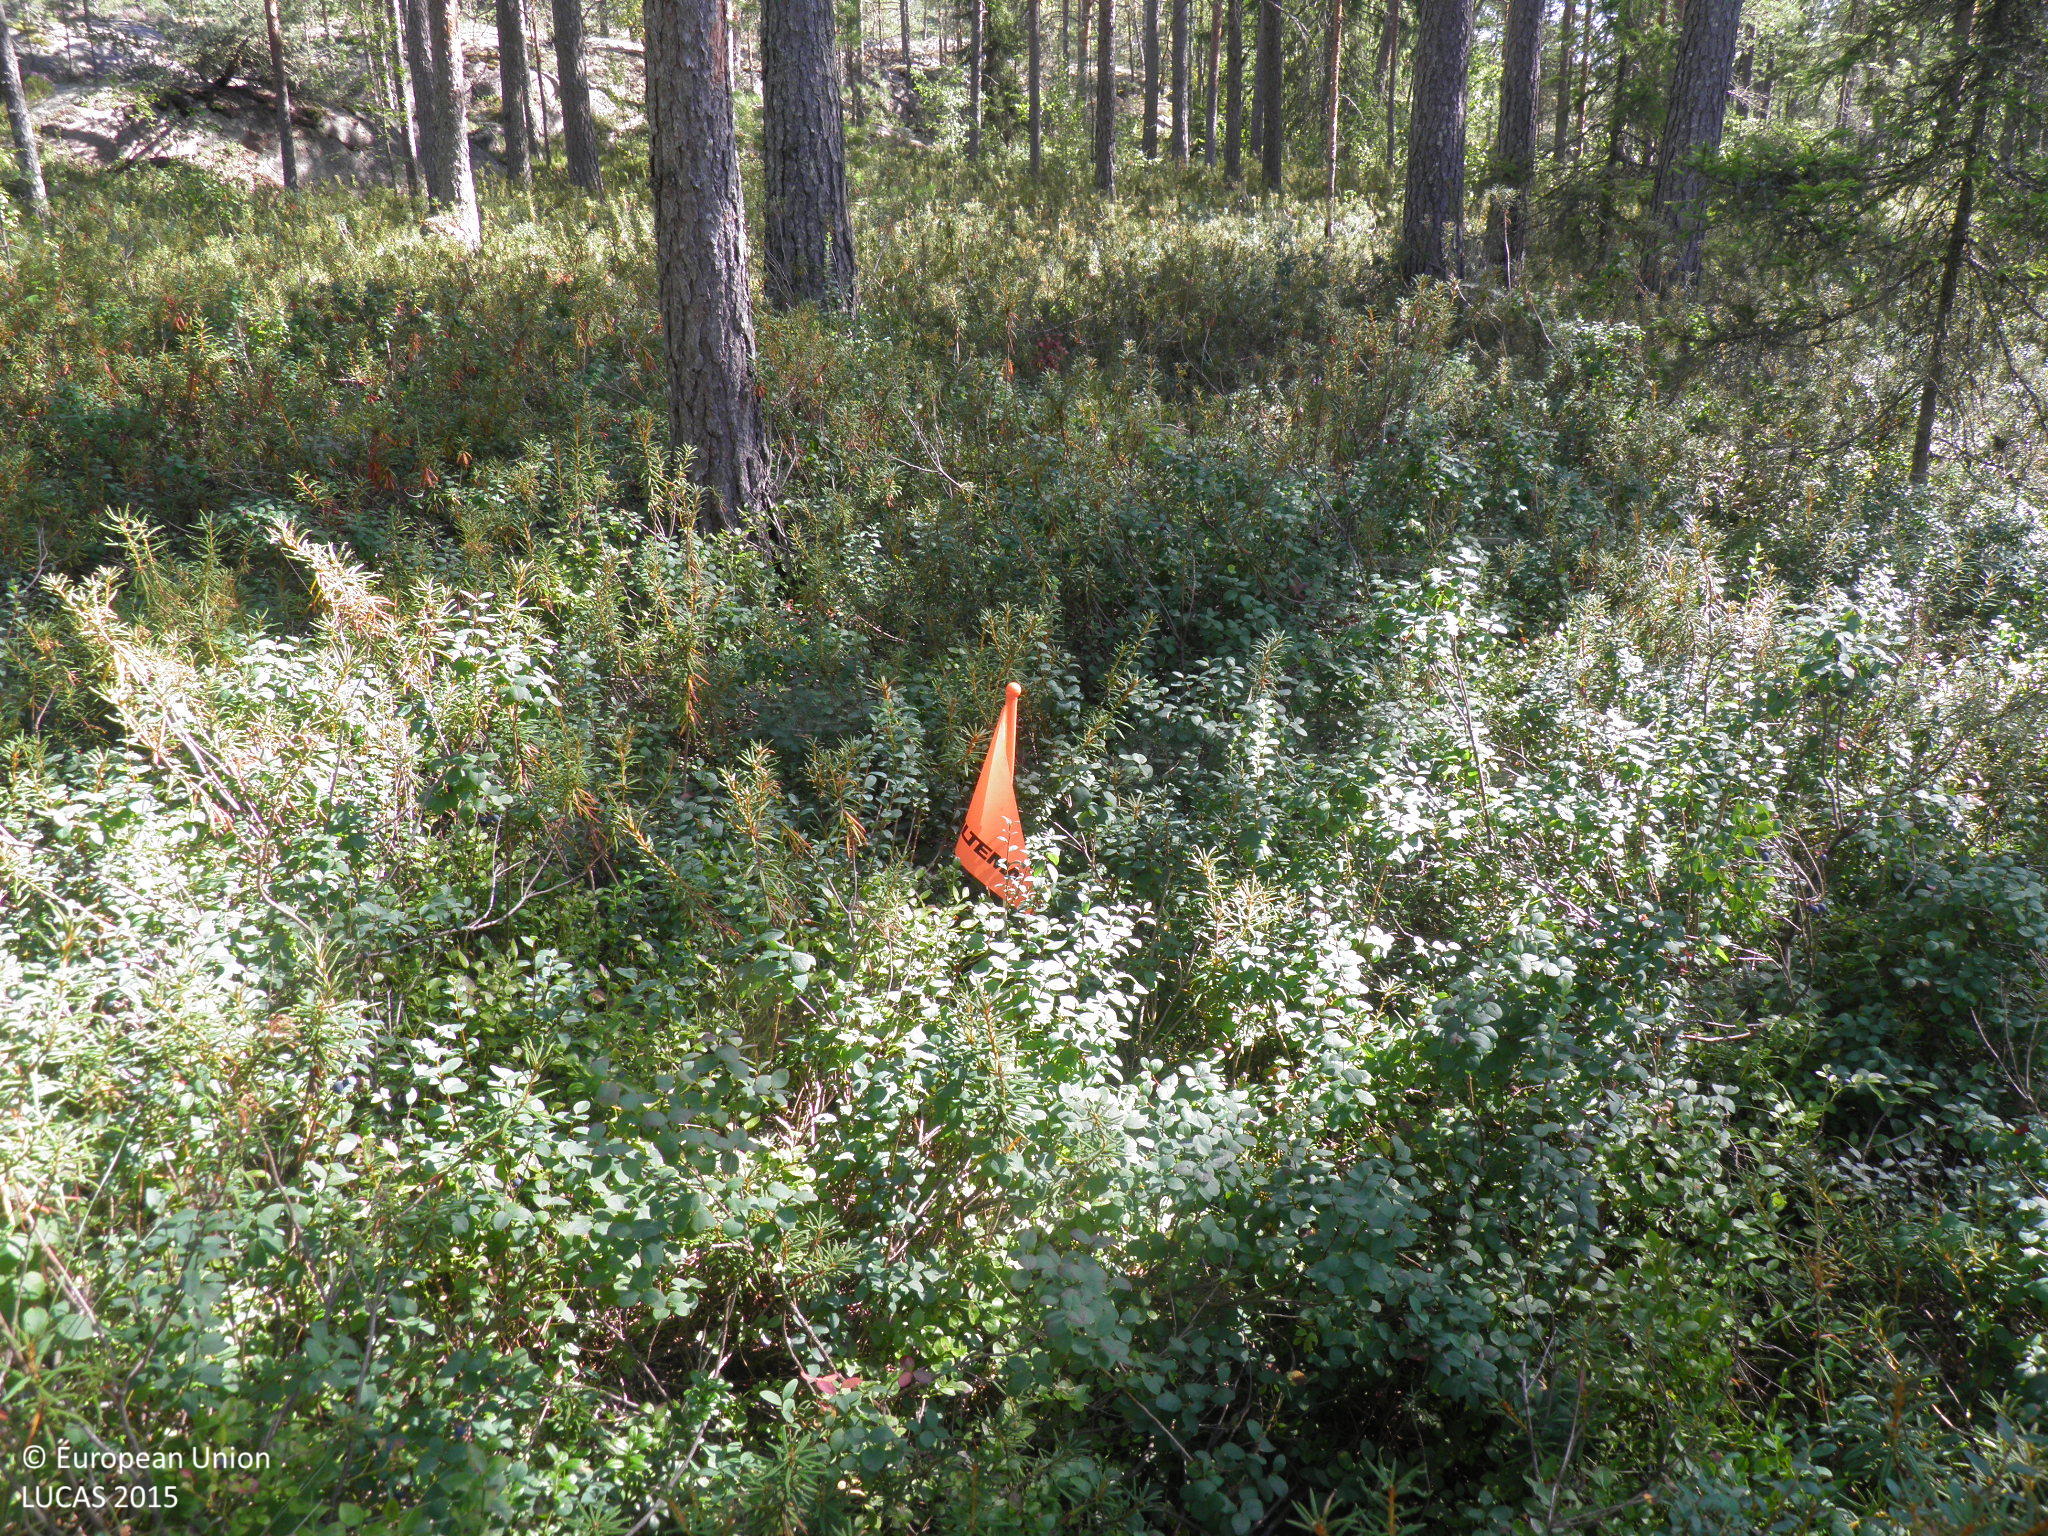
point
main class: Woodland
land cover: Pine dominated coniferous woodland
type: hemiboreal forest and nemoral coniferous forest and mixed broadleaved-coniferous forest
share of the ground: 50 - 75 %
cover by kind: coniferous forest trees 50 %, shrubs 30 %, lichens and mosses 10 %, consolidated bare surface 10 %
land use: Semi-natural and natural areas not in use
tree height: > 5 m
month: August
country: FI
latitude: 60.2077
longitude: 22.6873
